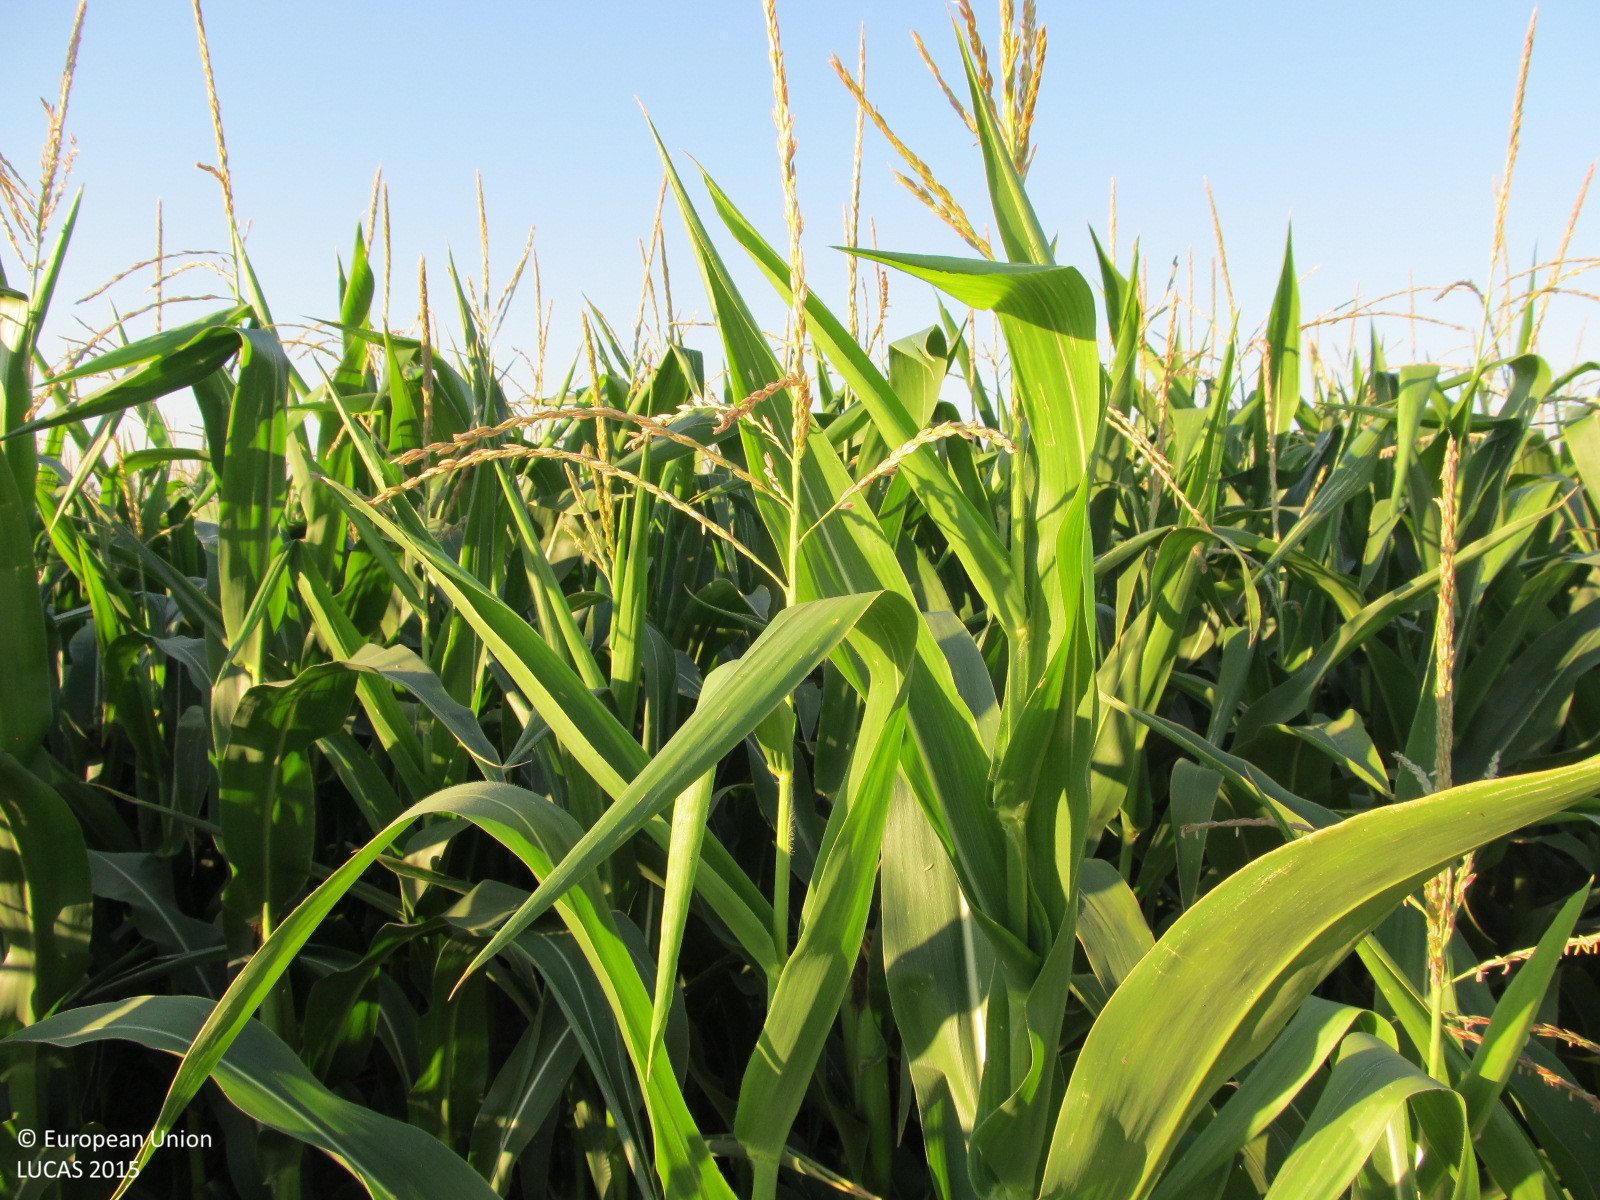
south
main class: Cropland
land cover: Maize
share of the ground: > 75 %
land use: Agriculture (excluding fallow land and kitchen gardens)
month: July
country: AT
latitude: 48.2785
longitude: 15.6219
